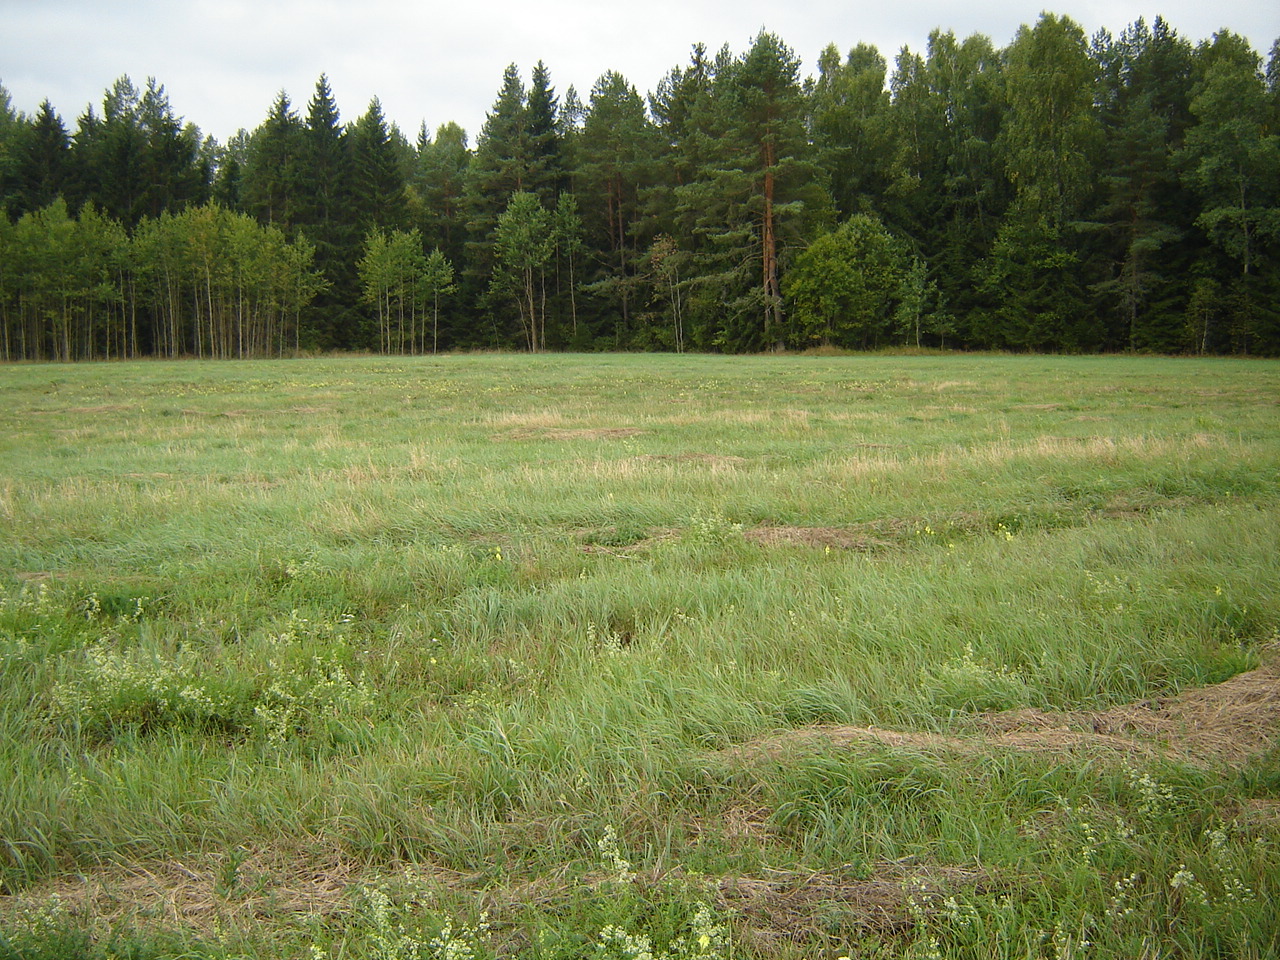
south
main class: Grassland
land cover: Grassland without tree/shrub cover
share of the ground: > 75 %
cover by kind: herbaceous plants 100 %
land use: Agriculture (excluding fallow land and kitchen gardens)
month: September
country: LT
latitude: 54.4006
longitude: 24.8531
